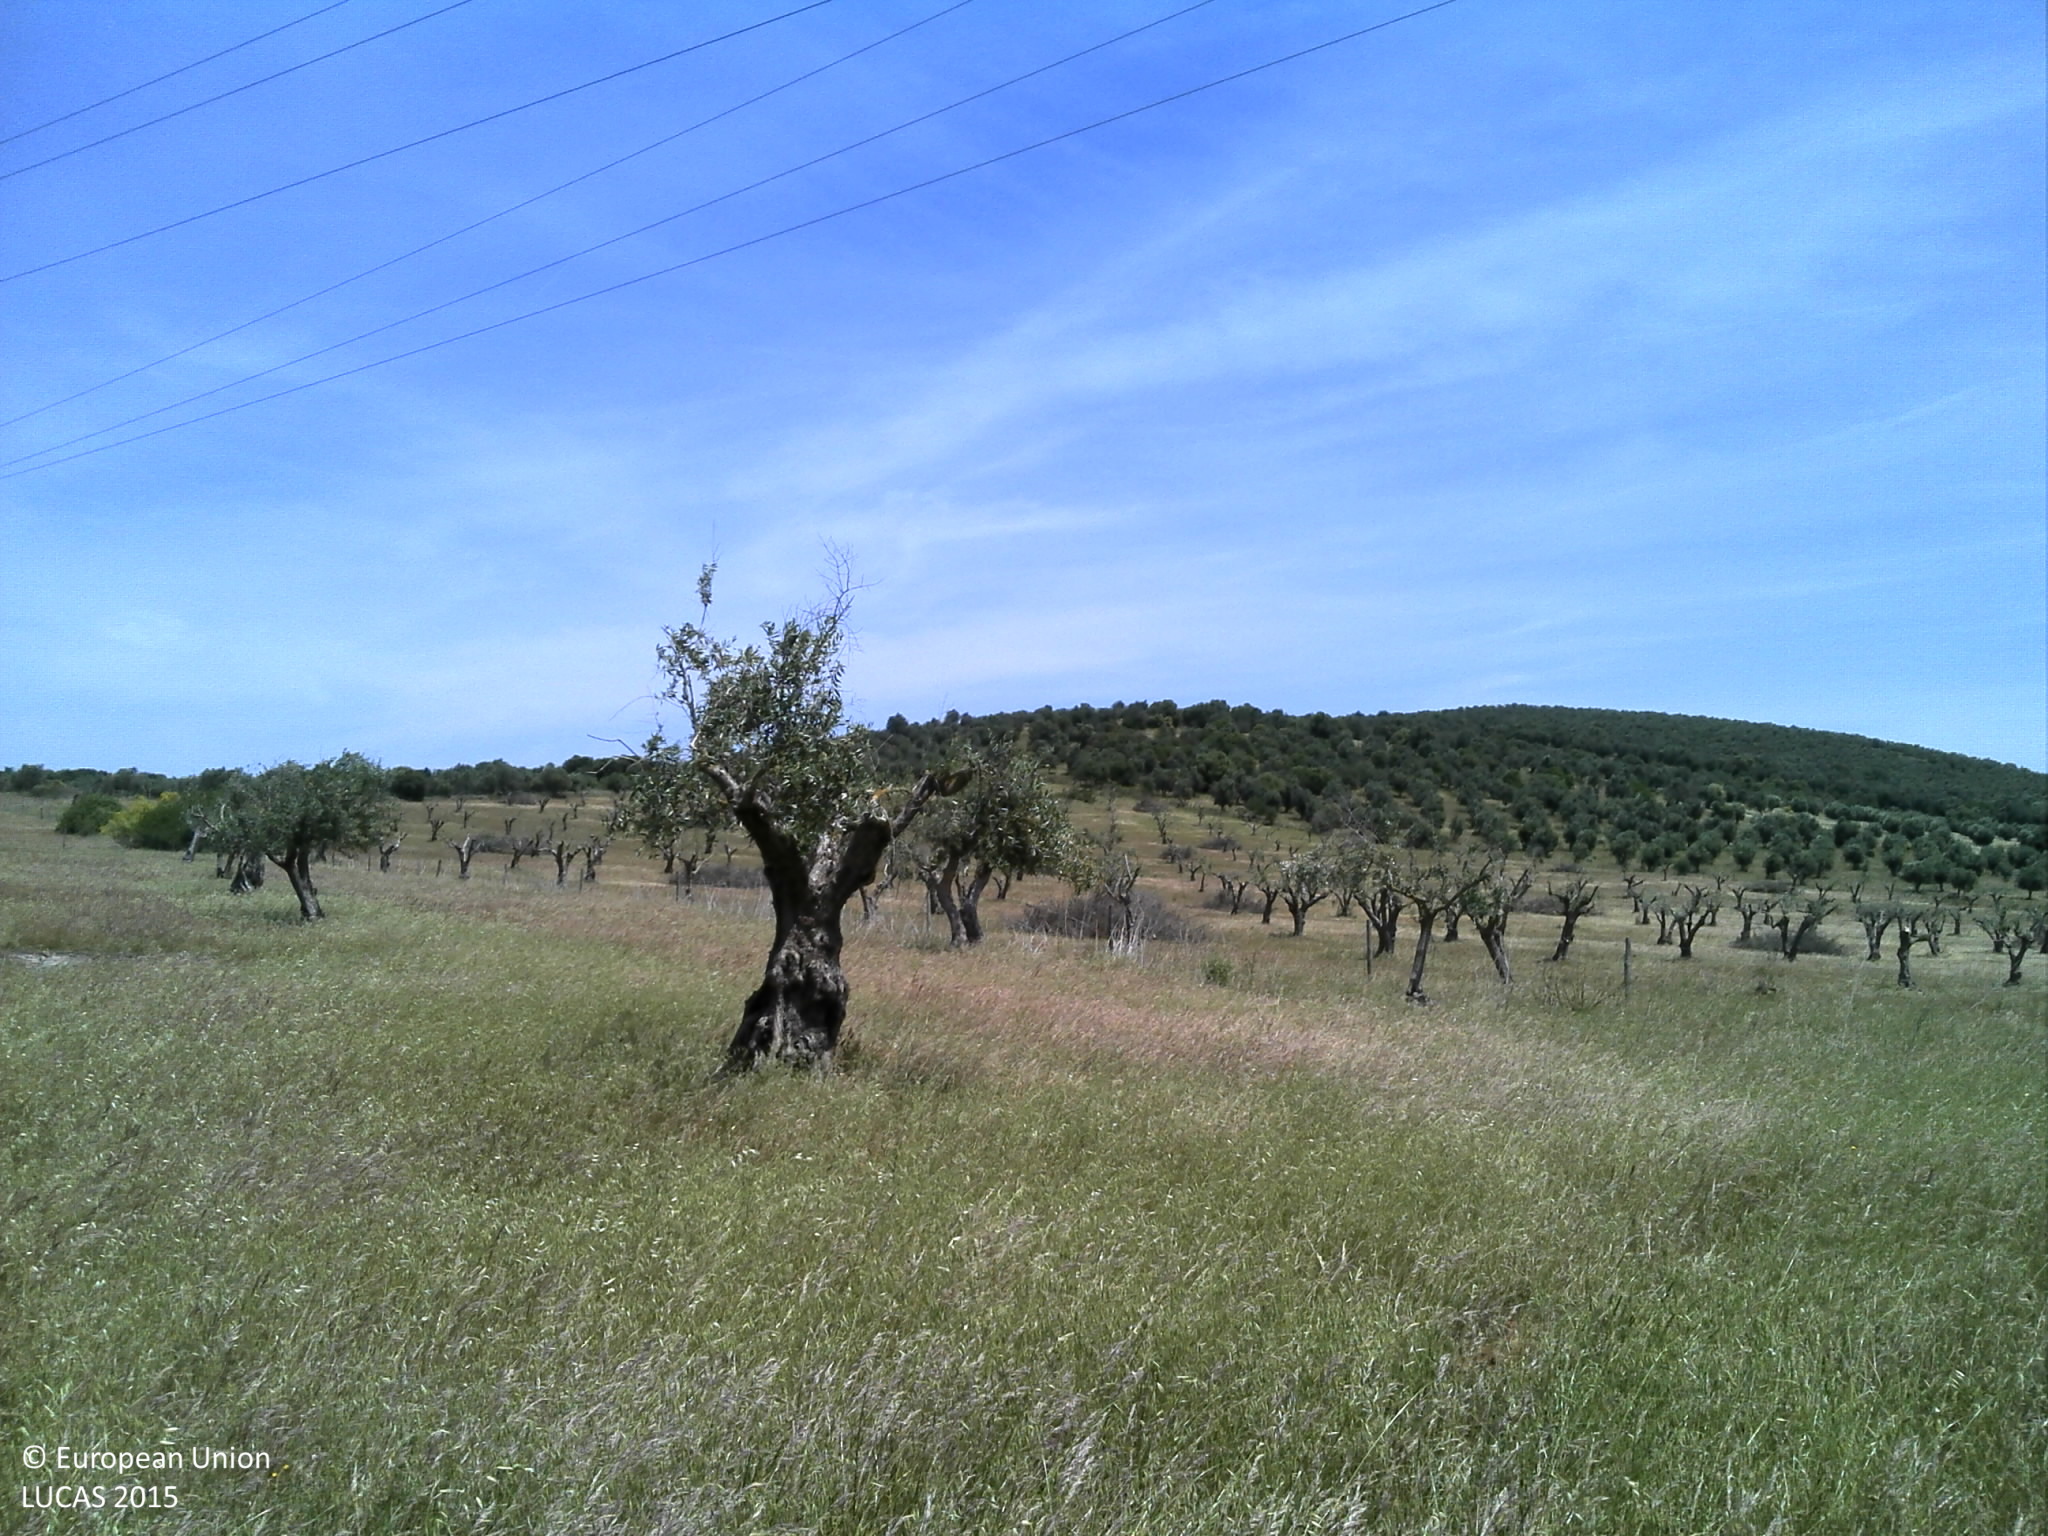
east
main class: Cropland
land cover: Olive groves
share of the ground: 10 - 25 %
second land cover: Grassland without tree/shrub cover
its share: 25 - 50 %
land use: Agriculture (excluding fallow land and kitchen gardens)
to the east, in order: Olive groves; Grassland without tree/shrub cover; Electric lines; Olive groves; Electric lines; Olive groves; Fences; Olive groves
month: May
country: PT
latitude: 39.1877
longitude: -7.6540
